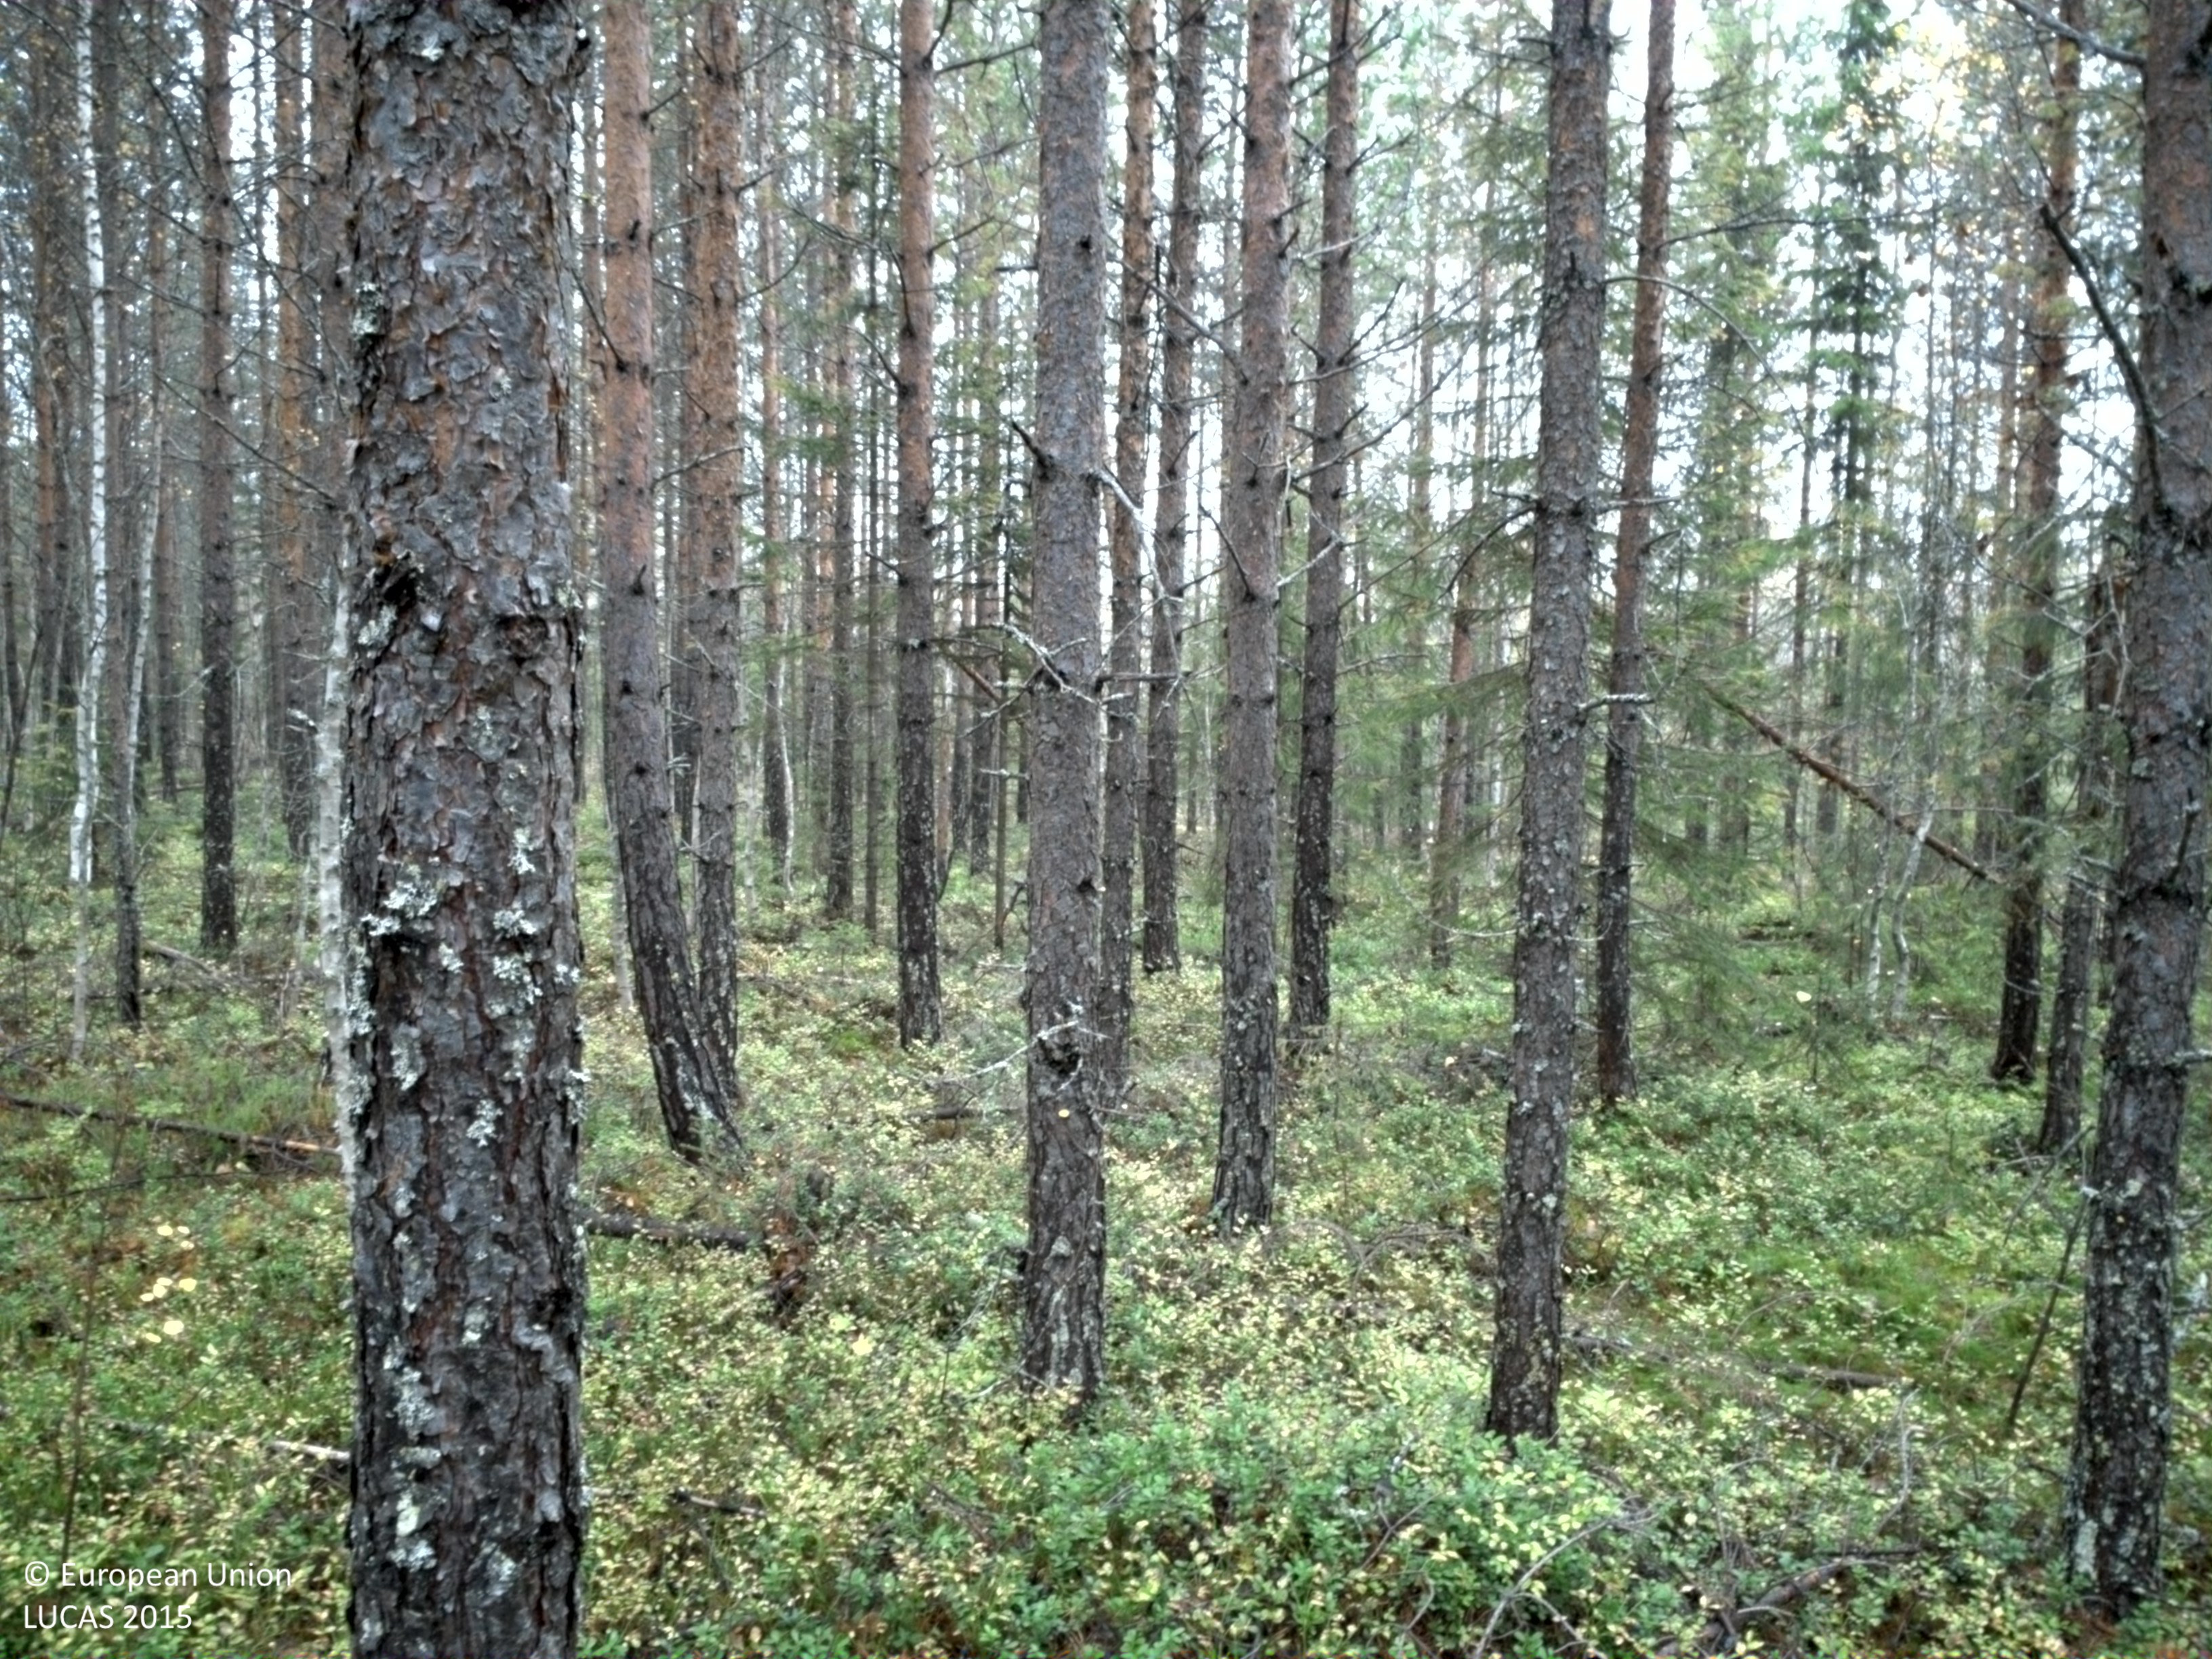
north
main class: Woodland
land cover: Pine dominated coniferous woodland
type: boreal forest
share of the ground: 25 - 50 %
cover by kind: shrubs 60 %, coniferous forest trees 40 %
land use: Forestry
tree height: > 5 m
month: September
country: SE
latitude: 65.6926
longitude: 22.1046
